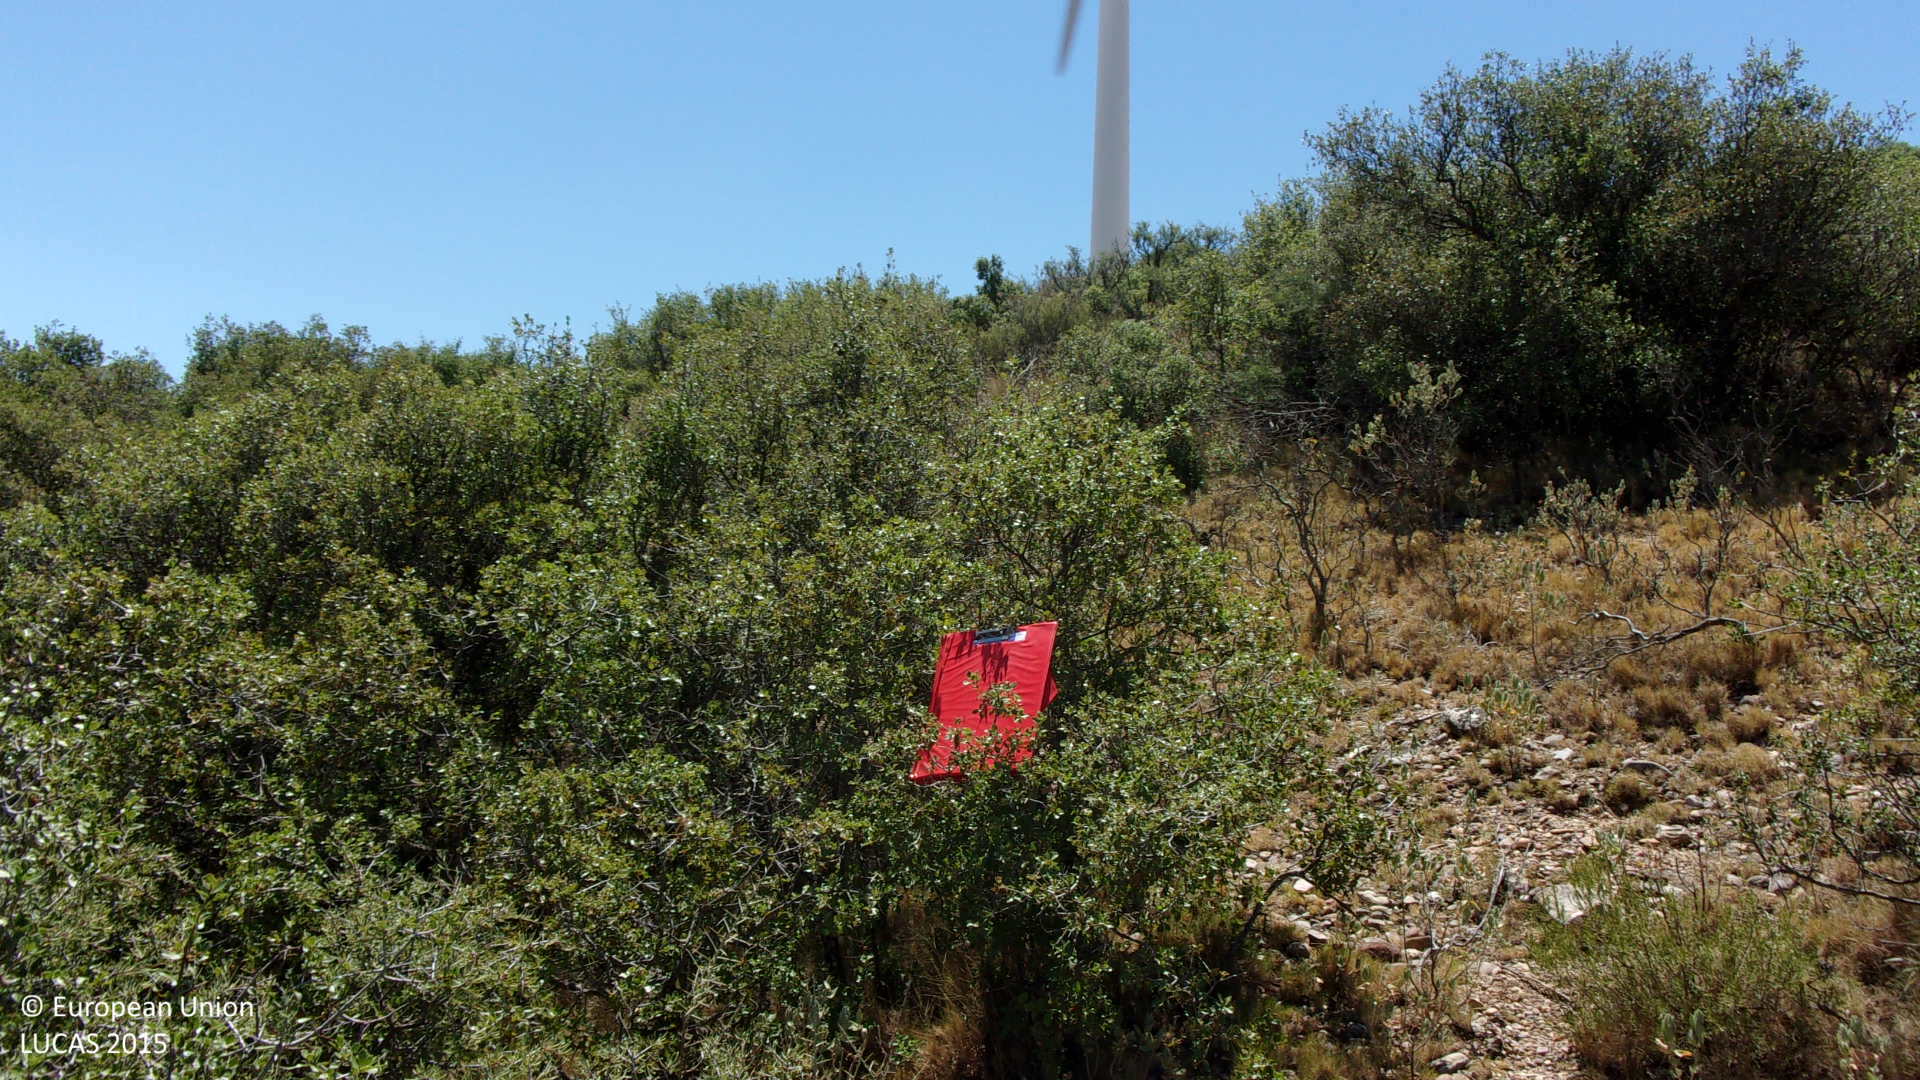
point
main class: Shrubland
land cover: Shrubland without tree cover
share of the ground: > 75 %
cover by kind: shrubs 85 %, consolidated bare surface 10 %, herbaceous plants 5 %
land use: Semi-natural and natural areas not in use
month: July
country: ES
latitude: 41.7140
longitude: -1.2633
